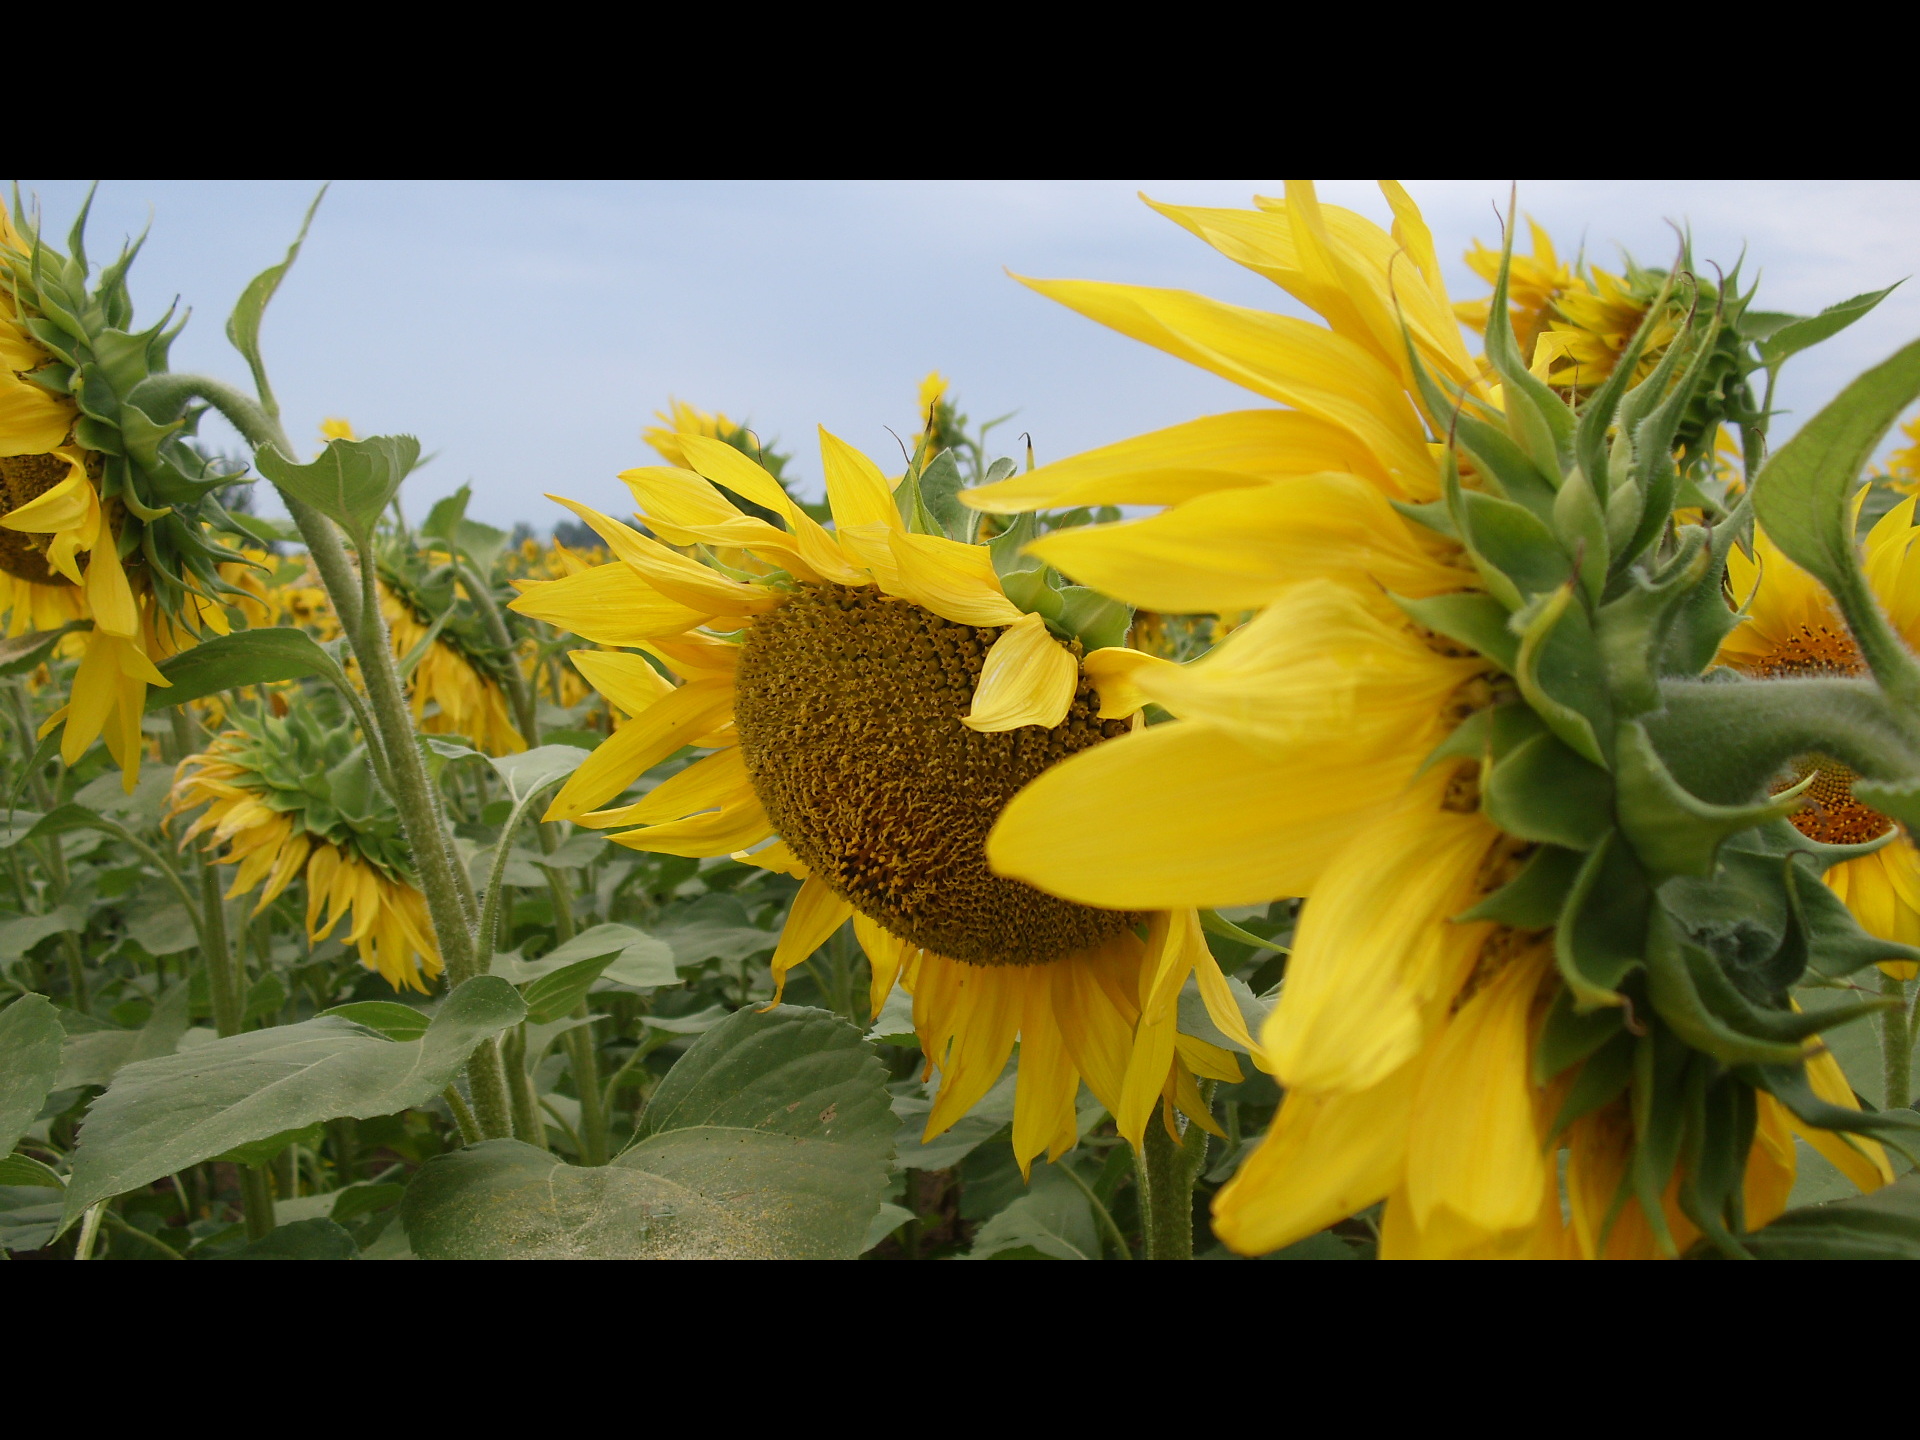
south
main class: Cropland
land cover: Sunflower
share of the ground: > 75 %
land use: Agriculture (excluding fallow land and kitchen gardens)
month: July
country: BG
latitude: 43.9333
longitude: 22.8317
